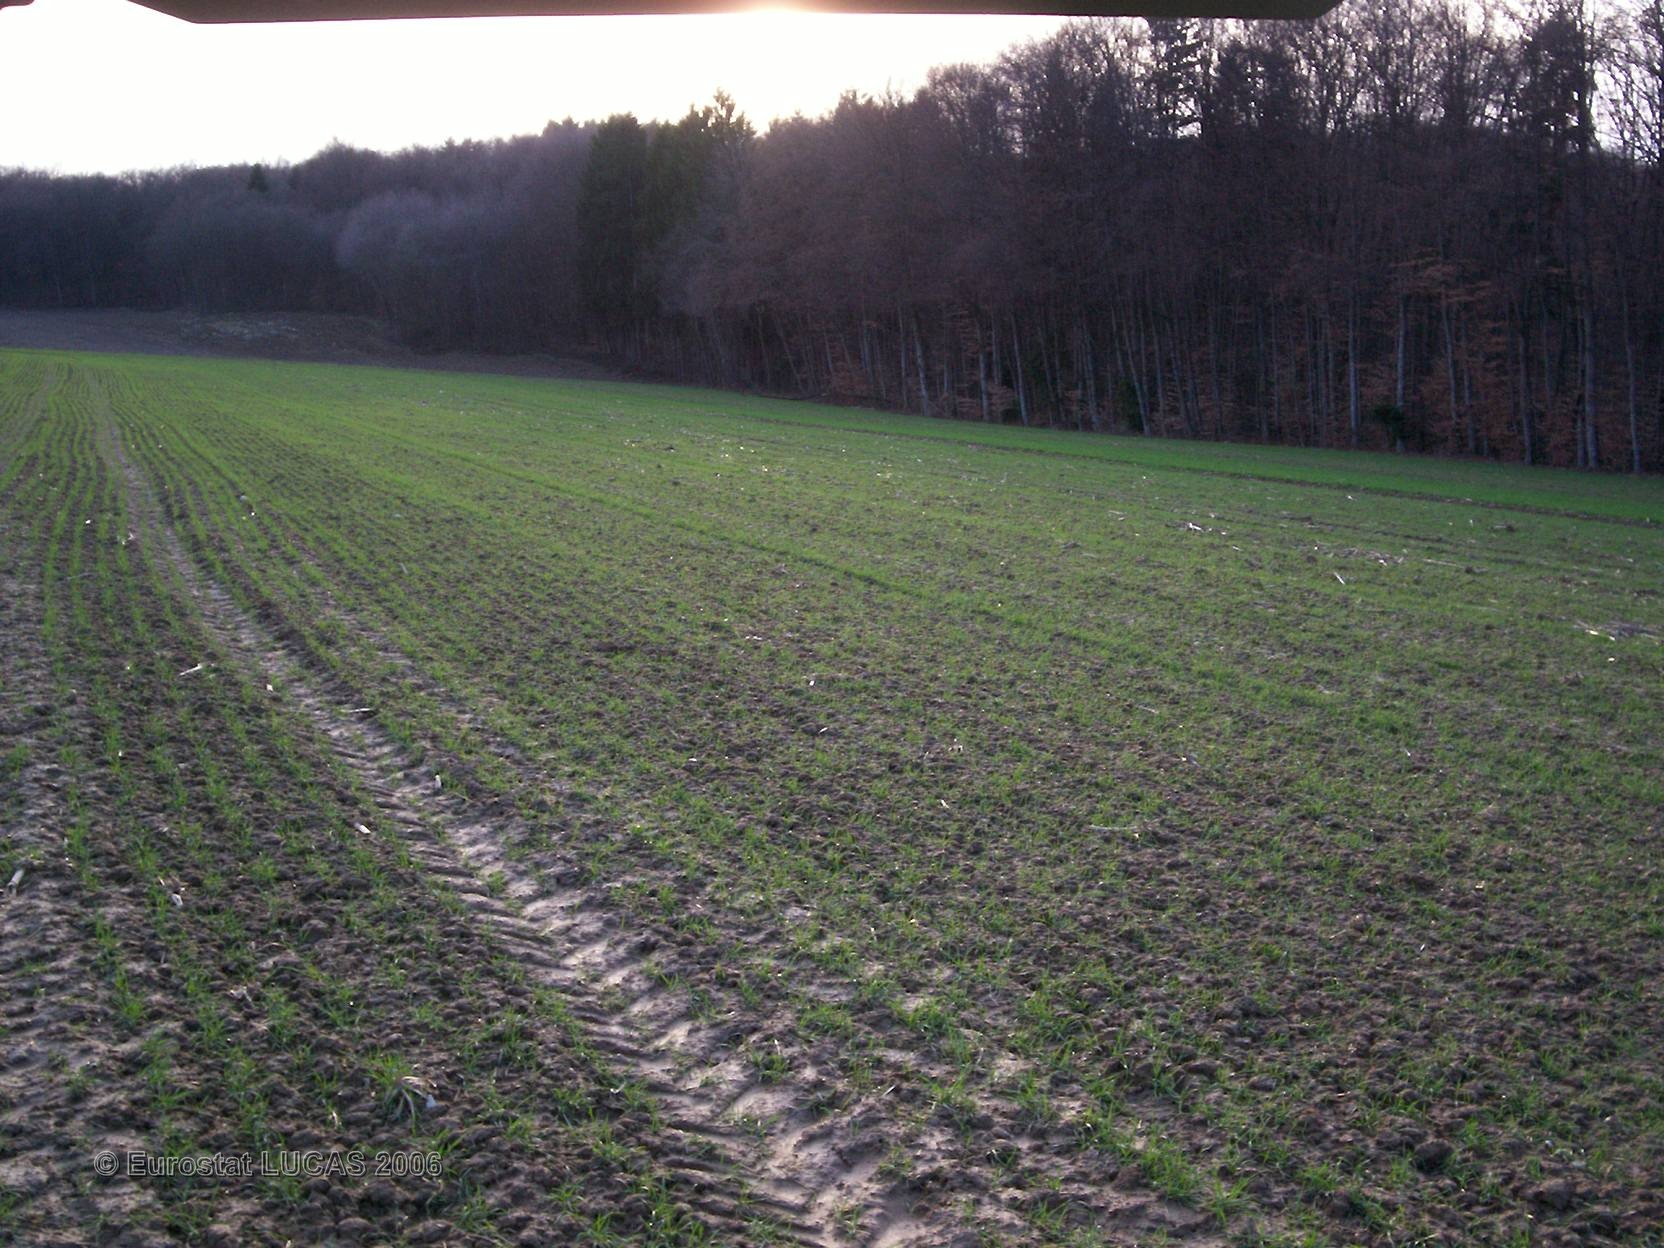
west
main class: Cropland
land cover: Common wheat
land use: Agriculture (excluding fallow land and kitchen gardens)
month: April
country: FR
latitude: 47.4621
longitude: 6.9905
